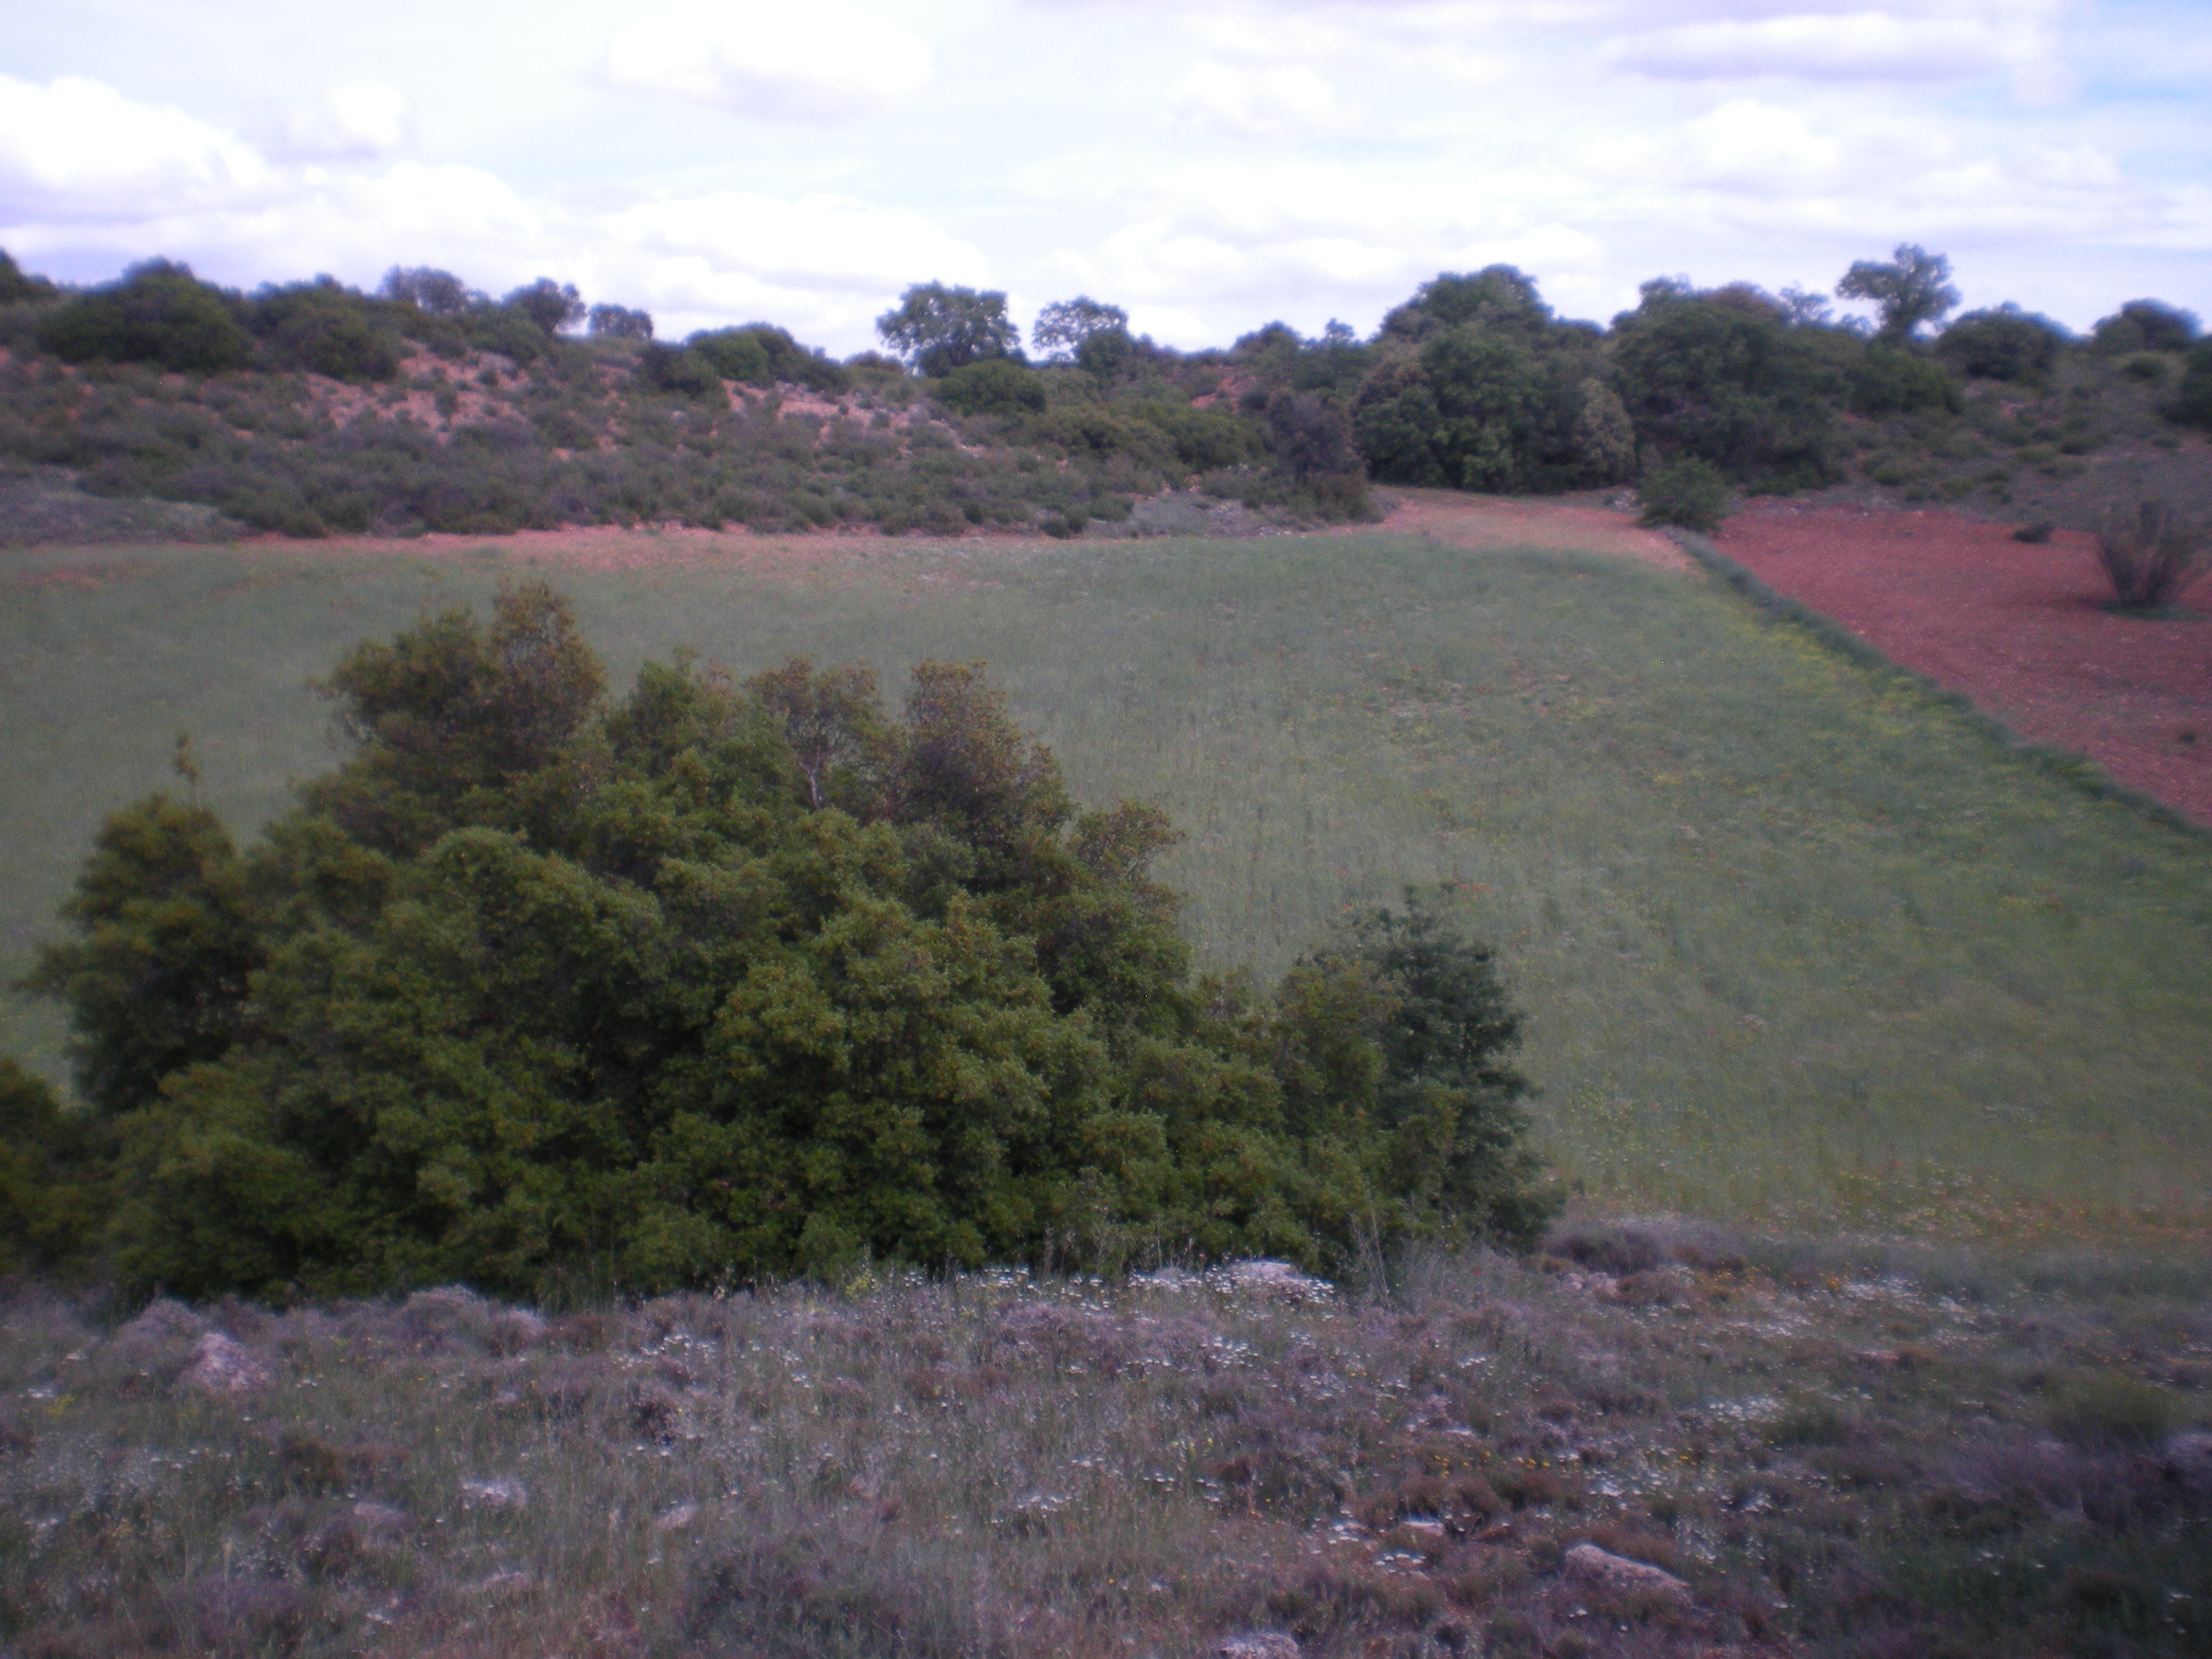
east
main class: Woodland
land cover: Broadleaved woodland
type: broadleaved evergreen forest
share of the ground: 25 - 50 %
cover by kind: herbaceous plants 50 %, shrubs 30 %, broadleaved forest trees 15 %, unconsolidated bare surface 5 %
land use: Semi-natural and natural areas not in use
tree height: > 5 m
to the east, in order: Broadleaved woodland; Barley; Broadleaved woodland; Tracks; Broadleaved woodland; Olive groves
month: May
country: ES
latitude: 38.8647
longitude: -3.0201
